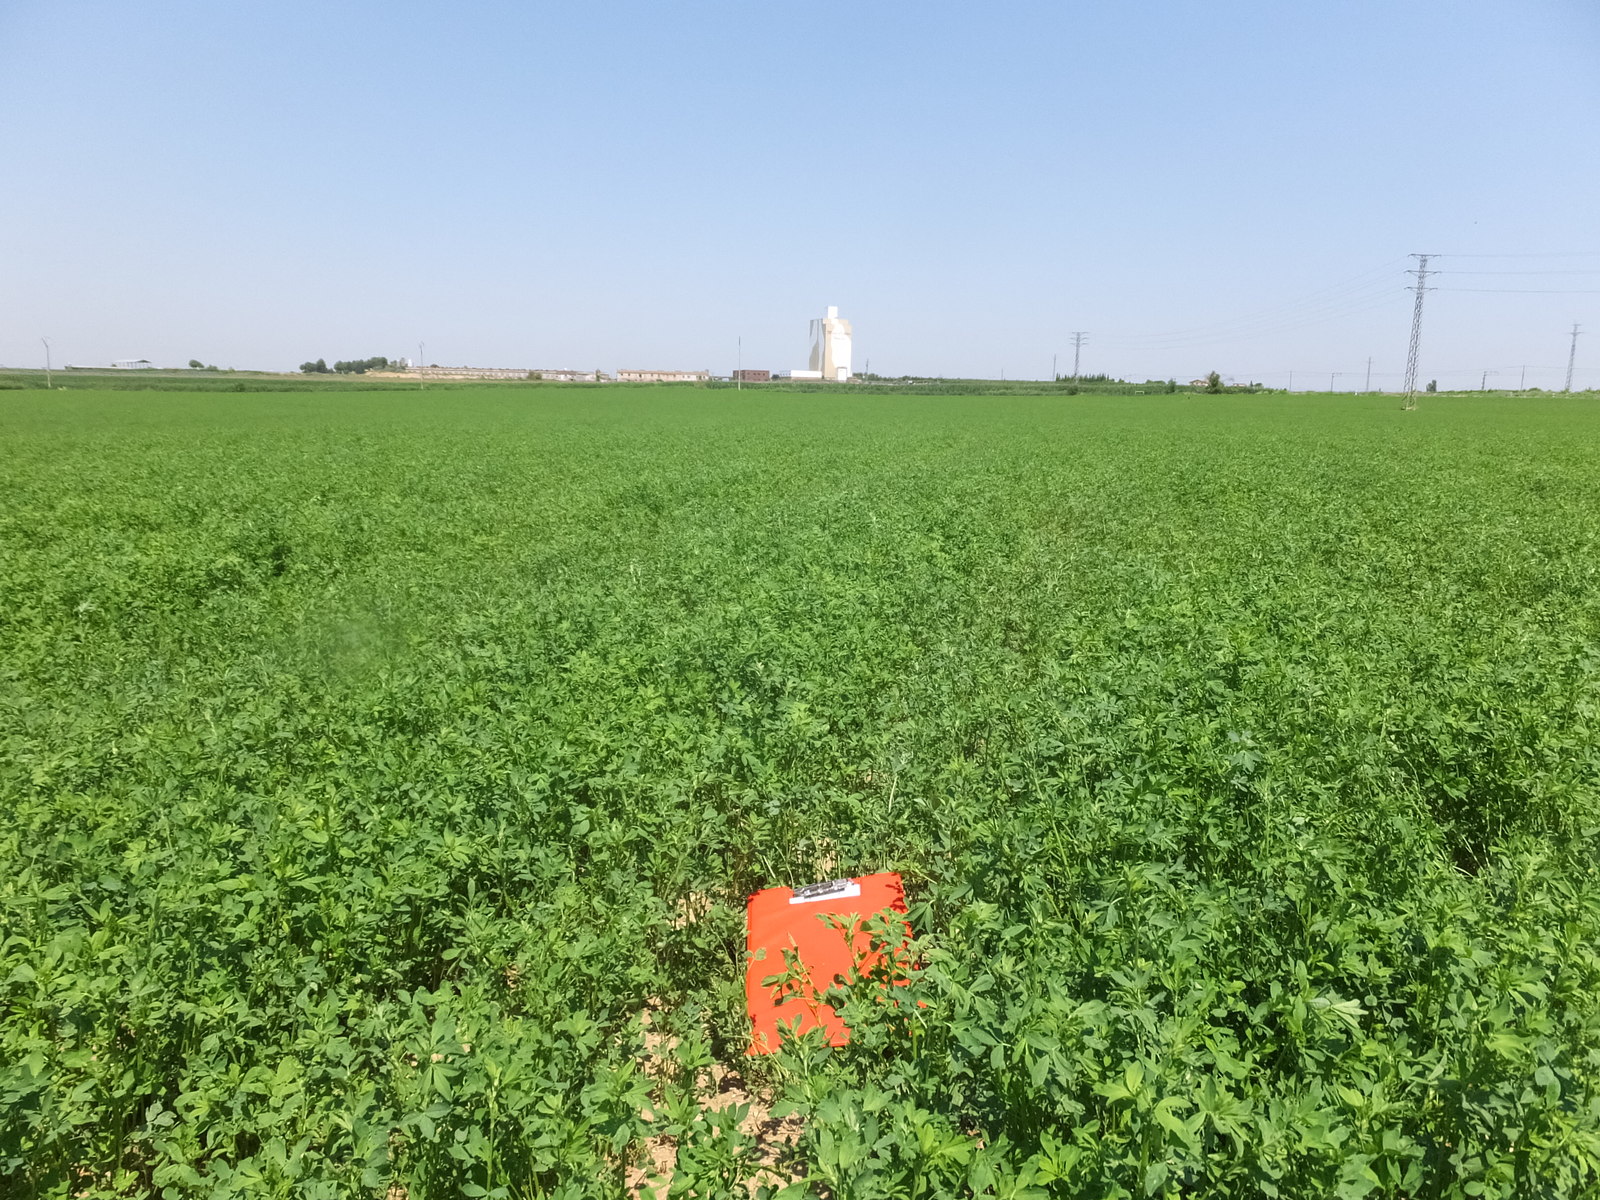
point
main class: Cropland
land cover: Lucerne
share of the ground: > 75 %
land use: Agriculture (excluding fallow land and kitchen gardens)
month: June
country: ES
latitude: 41.7607
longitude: 0.3993
